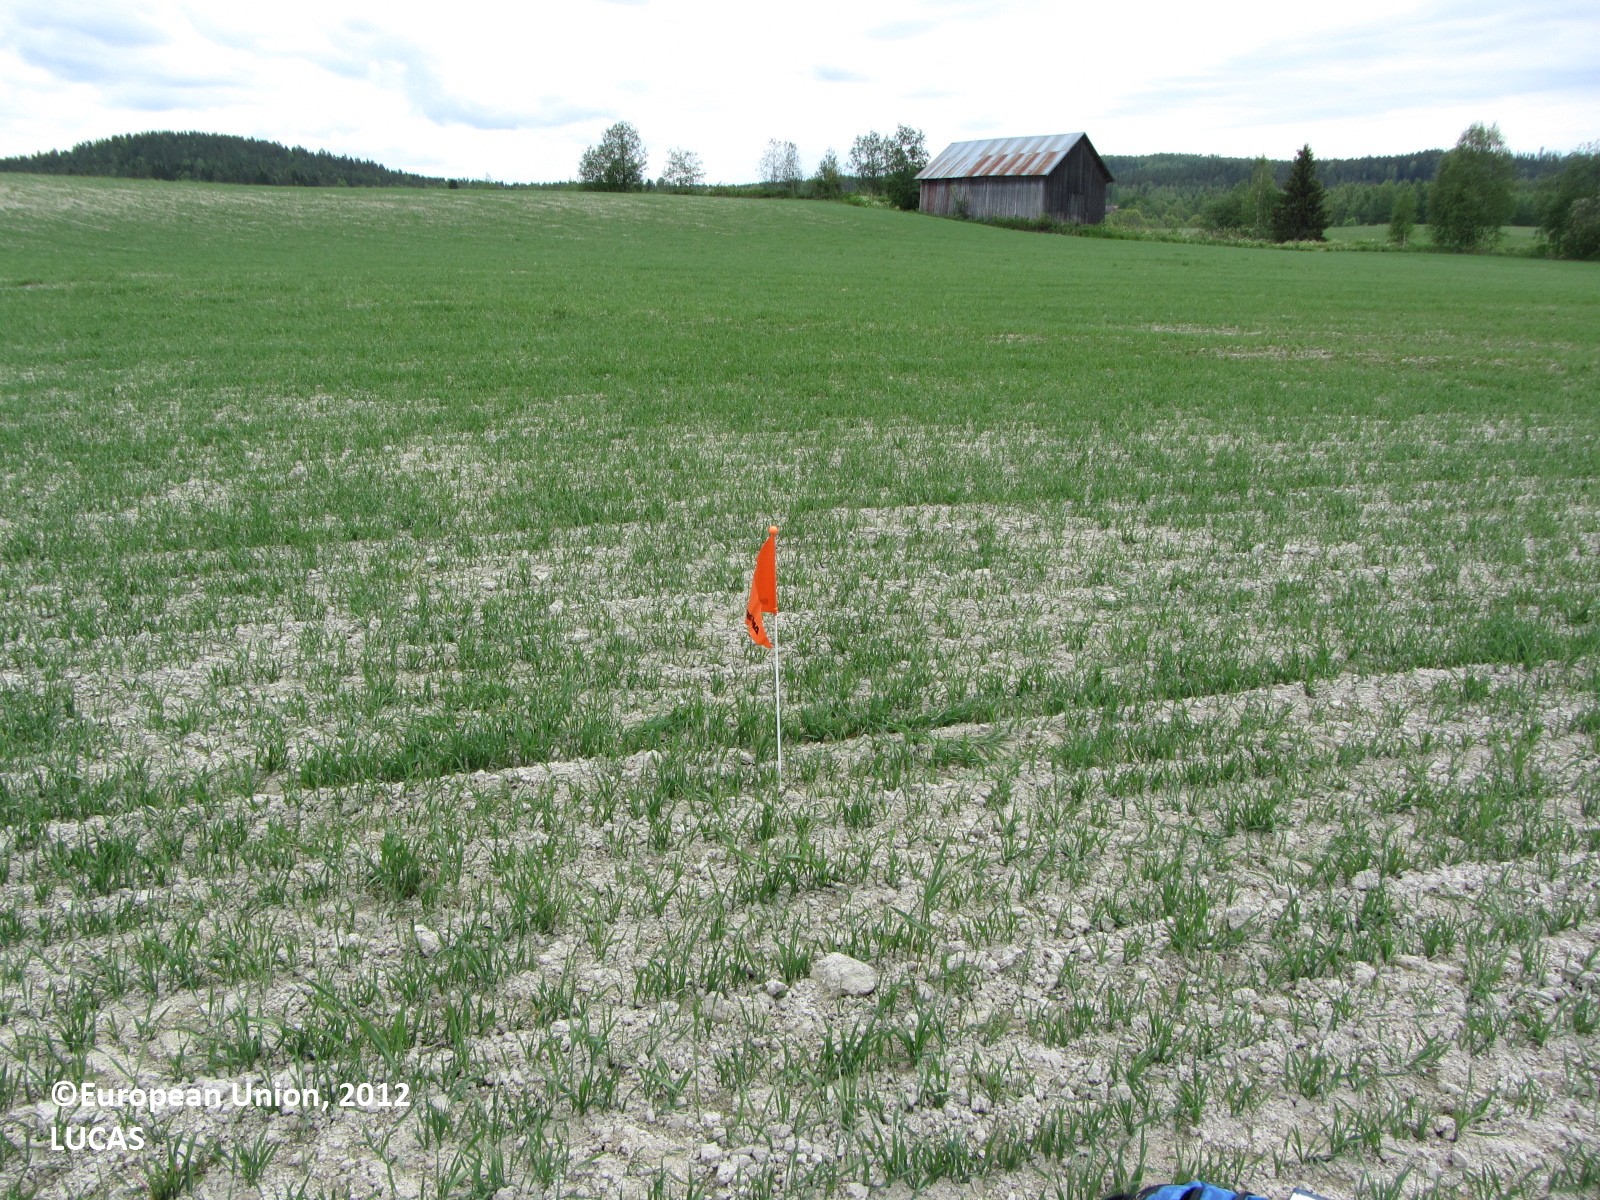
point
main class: Cropland
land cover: Oats
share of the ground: 50 - 75 %
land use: Agriculture (excluding fallow land and kitchen gardens)
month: June
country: FI
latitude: 61.7095
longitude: 24.7993
